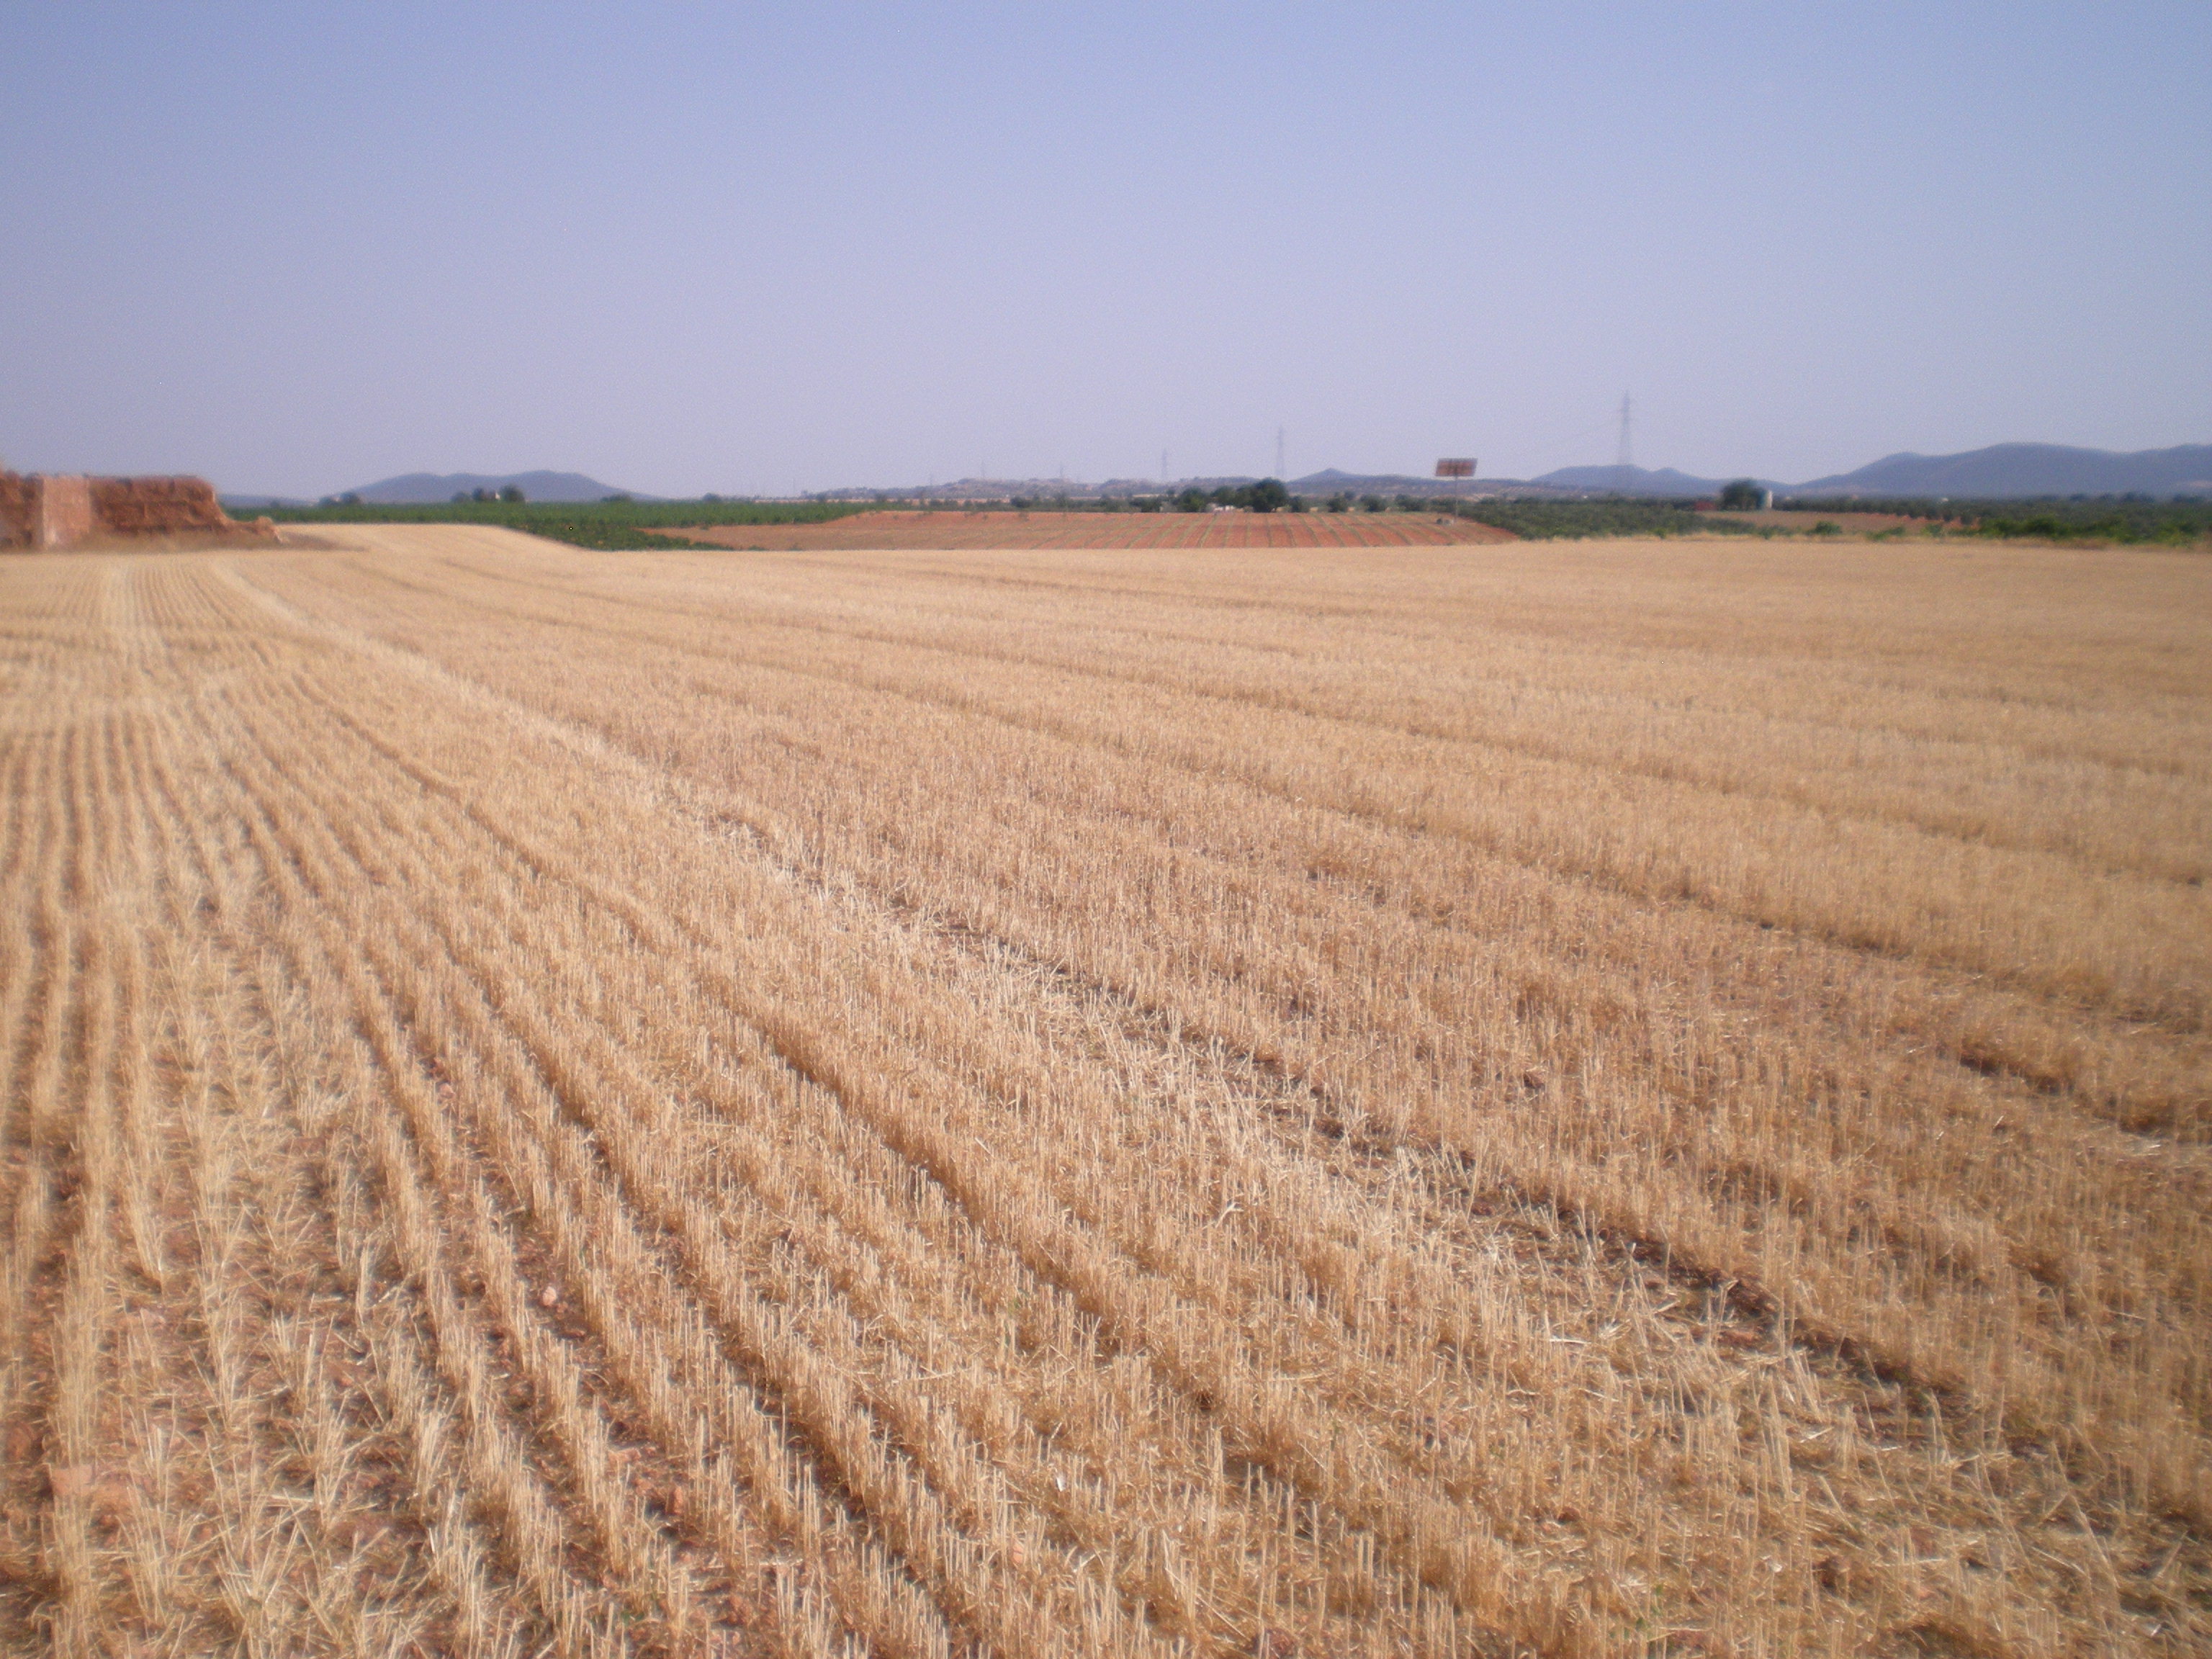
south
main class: Cropland
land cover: Common wheat
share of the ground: < 10 %
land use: Agriculture (excluding fallow land and kitchen gardens)
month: July
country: ES
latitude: 39.4201
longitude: -3.5074
